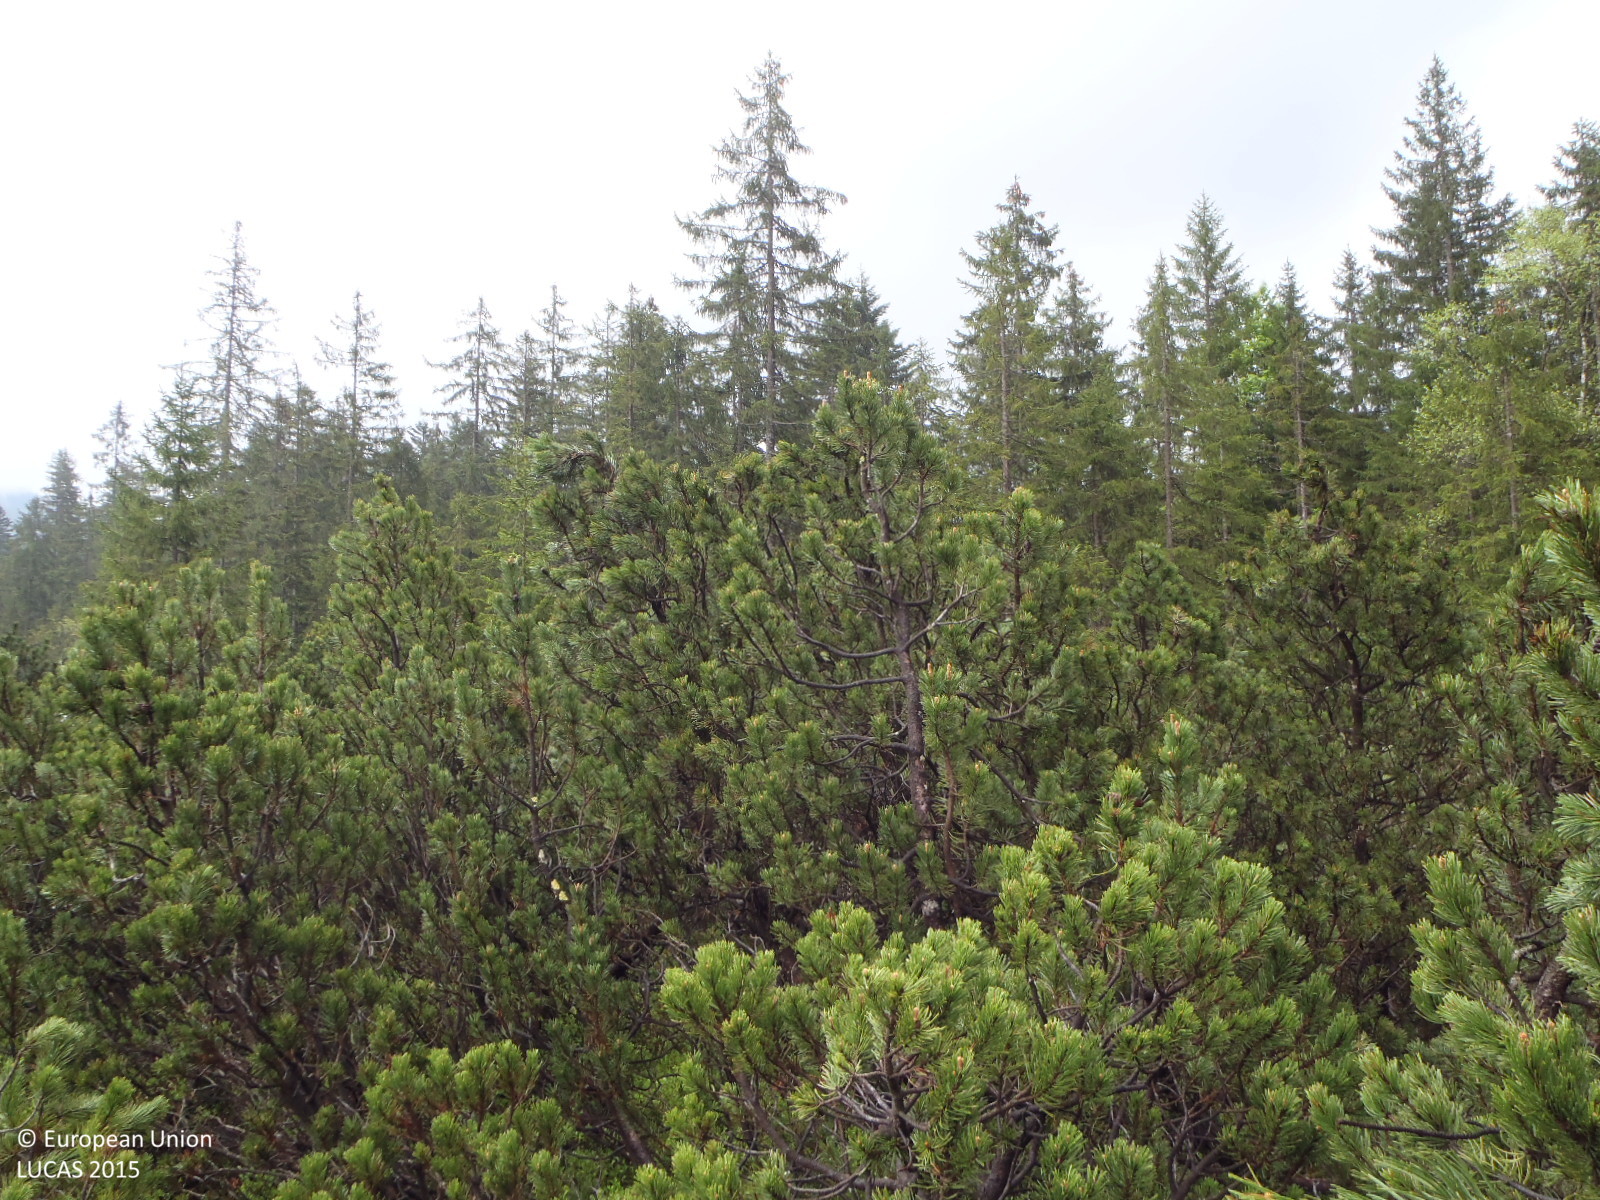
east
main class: Woodland
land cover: Pine dominated coniferous woodland
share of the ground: > 75 %
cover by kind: coniferous forest trees 80 %, herbaceous plants 10 %, shrubs 5 %, lichens and mosses 5 %
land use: Forestry
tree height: < 5 m
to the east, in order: Pine dominated coniferous woodland; Spruce dominated coniferous woodland; Rivers and streams; Spruce dominated coniferous woodland; Rivers and streams; Spruce dominated coniferous woodland; Inland fresh running water; Spruce dominated mixed woodland; Spruce dominated coniferous woodland
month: May
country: AT
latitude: 47.6528
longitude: 12.5946
